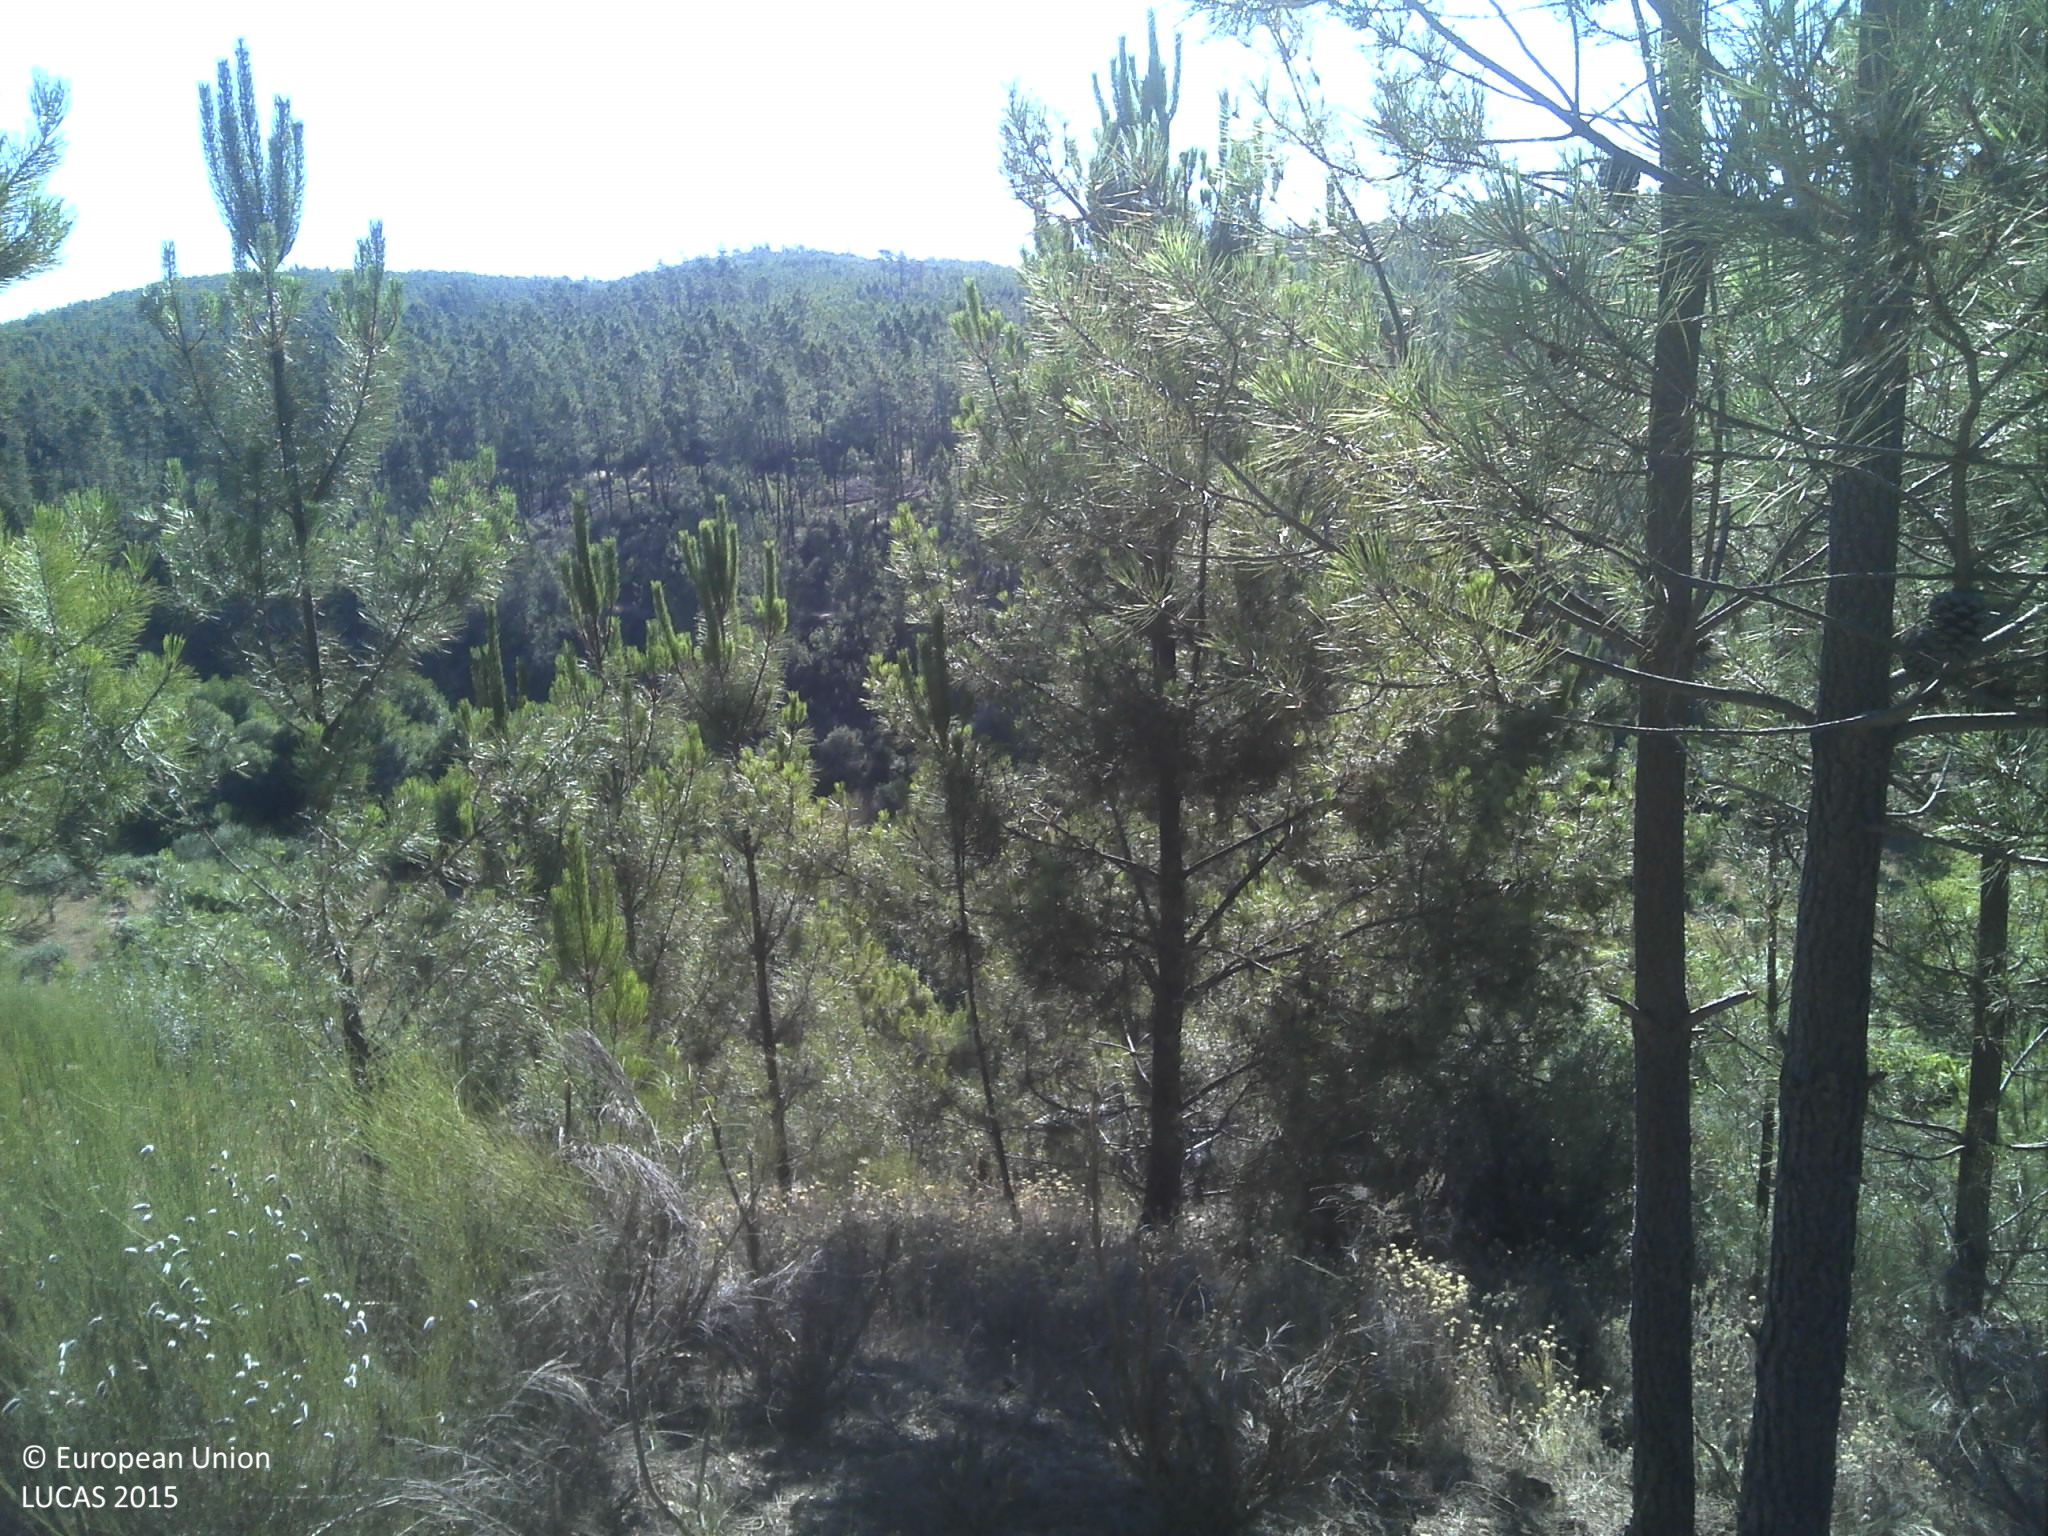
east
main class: Woodland
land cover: Pine dominated coniferous woodland
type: coniferous forest of the mediterranean region
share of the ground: 25 - 50 %
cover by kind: unconsolidated bare surface 40 %, coniferous forest trees 35 %, shrubs 25 %
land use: Forestry
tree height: > 5 m
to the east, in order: Pine dominated coniferous woodland; Shrubland with sparse tree cover; Tracks; Shrubland with sparse tree cover; Broadleaved woodland; Inland fresh running water; Shrubland with sparse tree cover; Fences; Spontaneously vegetated surfaces; Fences; Olive groves; Tracks; Pine dominated coniferous woodland; Tracks; Pine dominated coniferous woodland
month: July
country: PT
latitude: 39.9806
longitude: -7.6592
